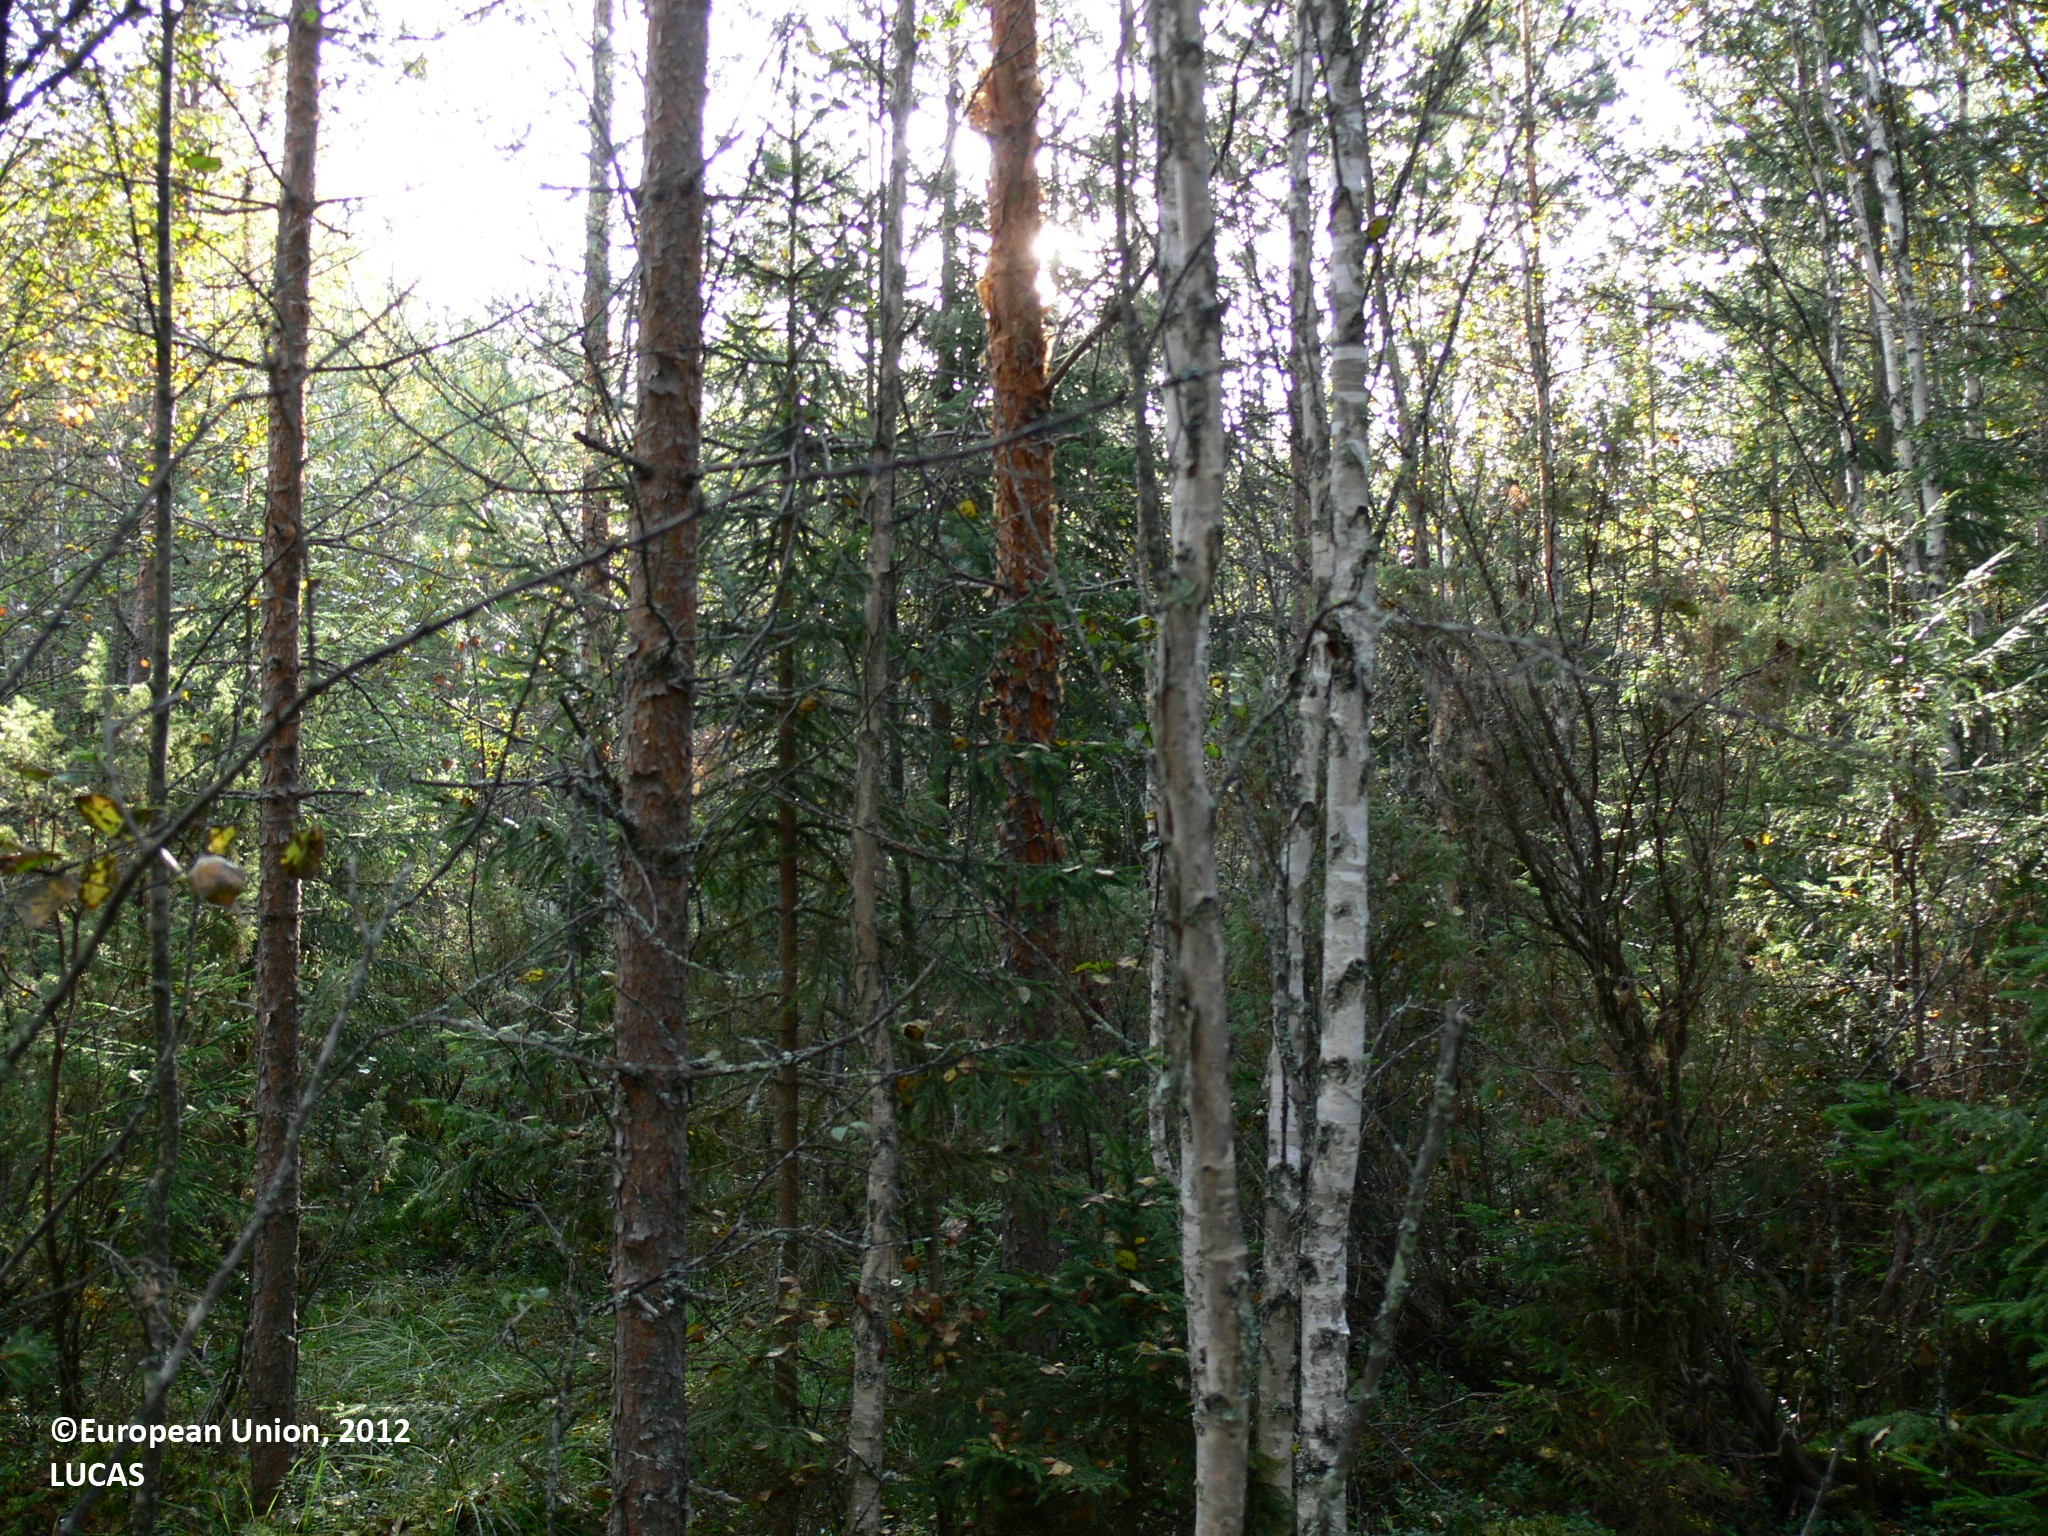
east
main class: Woodland
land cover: Other mixed woodland
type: boreal forest
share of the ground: > 75 %
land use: Forestry
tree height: > 5 m
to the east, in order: Other mixed woodland; Ditches and canals; Spruce dominated mixed woodland; Other mixed woodland; Pine dominated mixed woodland; Shrubland with sparse tree cover; Shruby margins; Railways; Shrubland with sparse tree cover; Spruce dominated mixed woodland; Pine dominated mixed woodland
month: September
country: FI
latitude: 63.2380
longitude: 30.1018
